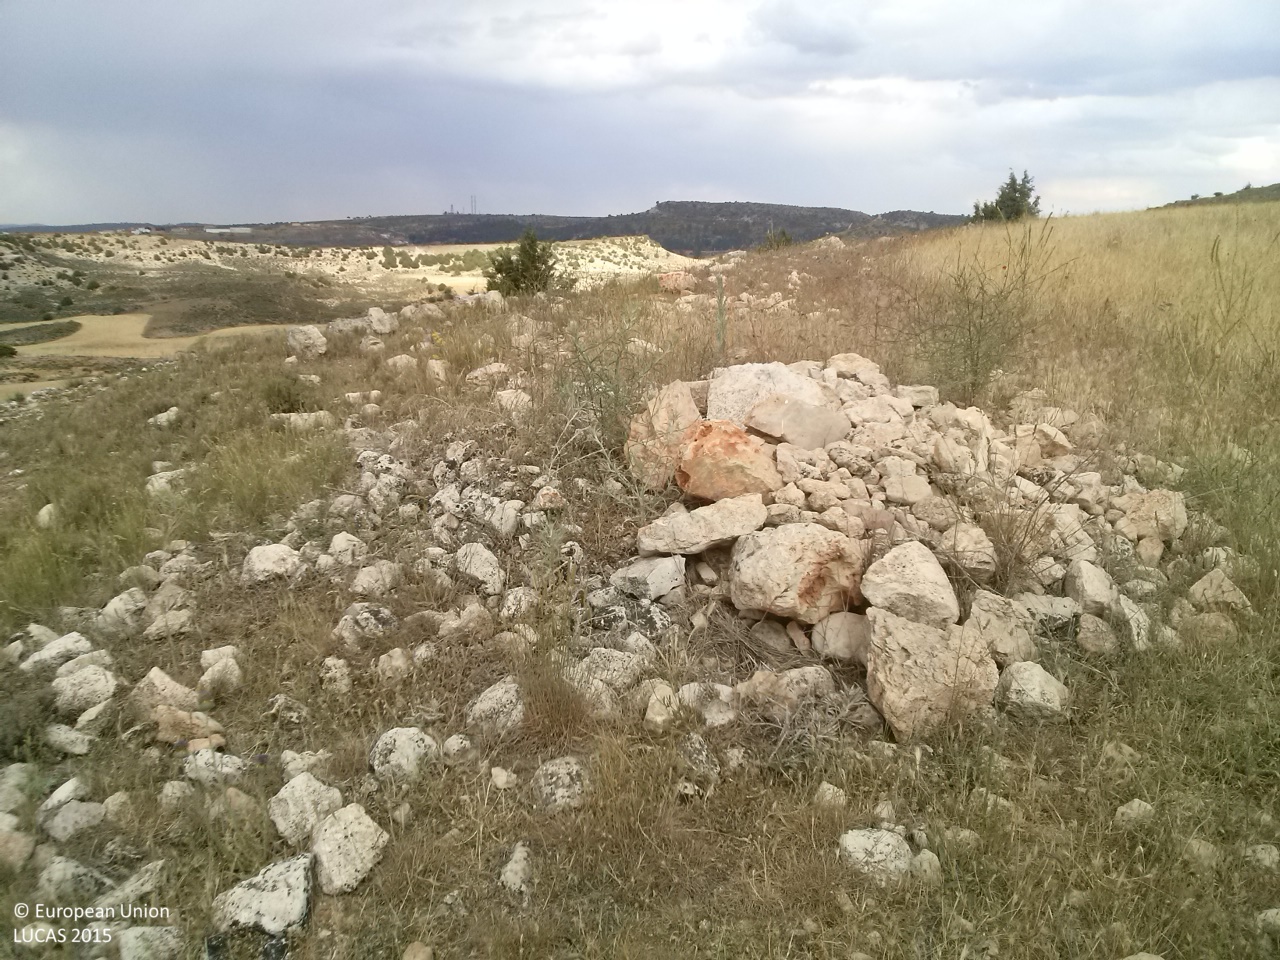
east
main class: Grassland
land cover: Grassland without tree/shrub cover
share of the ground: > 75 %
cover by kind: herbaceous plants 80 %, consolidated bare surface 20 %
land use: Agriculture (excluding fallow land and kitchen gardens)
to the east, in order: Grassland without tree/shrub cover; Rock outcrops; Grassland with sparse tree/shrub cover; Tracks; Grass margins; Shrubland without tree cover; Single bushes/trees; Barley; Grass margins; Fences; Grassland without tree/shrub cover
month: June
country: ES
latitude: 39.8954
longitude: -1.8352
